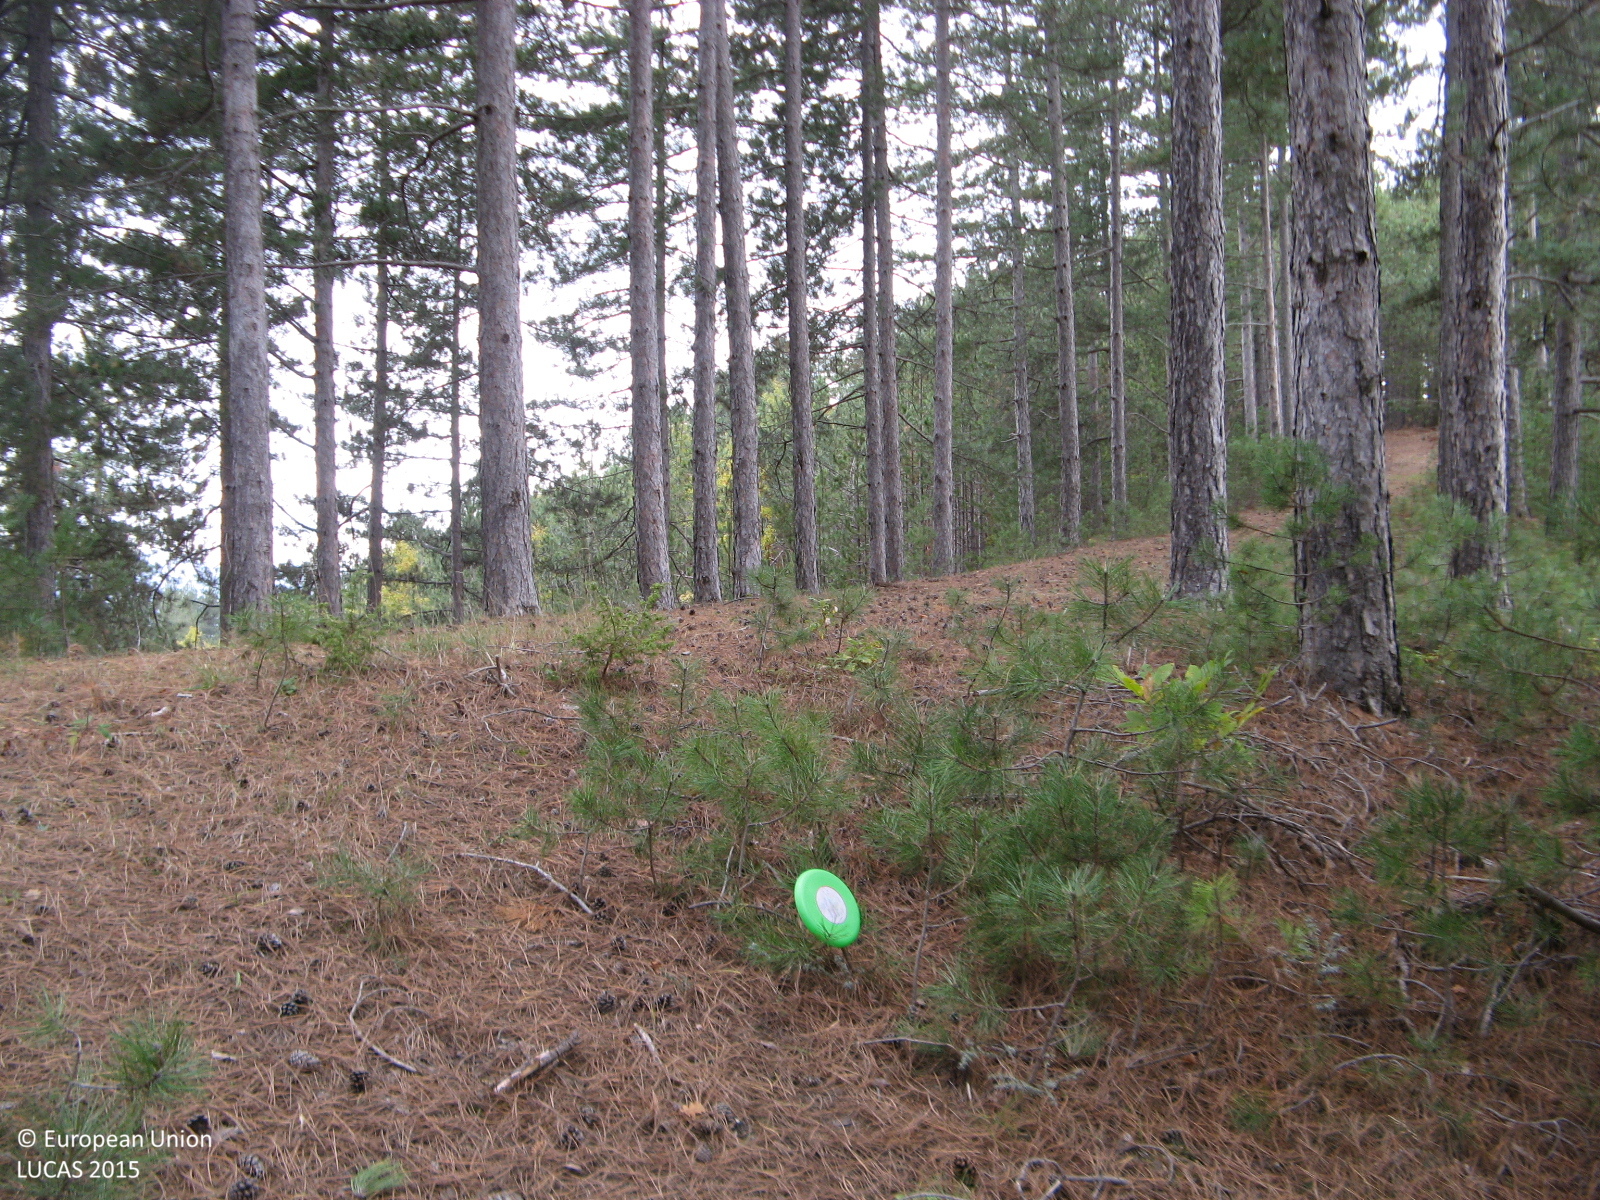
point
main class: Woodland
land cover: Pine dominated coniferous woodland
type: hemiboreal forest and nemoral coniferous forest and mixed broadleaved-coniferous forest
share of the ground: > 75 %
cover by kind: coniferous forest trees 85 %, unconsolidated bare surface 10 %, shrubs 5 %
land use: Forestry
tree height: > 5 m
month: November
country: BG
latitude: 41.4279
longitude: 25.0660
